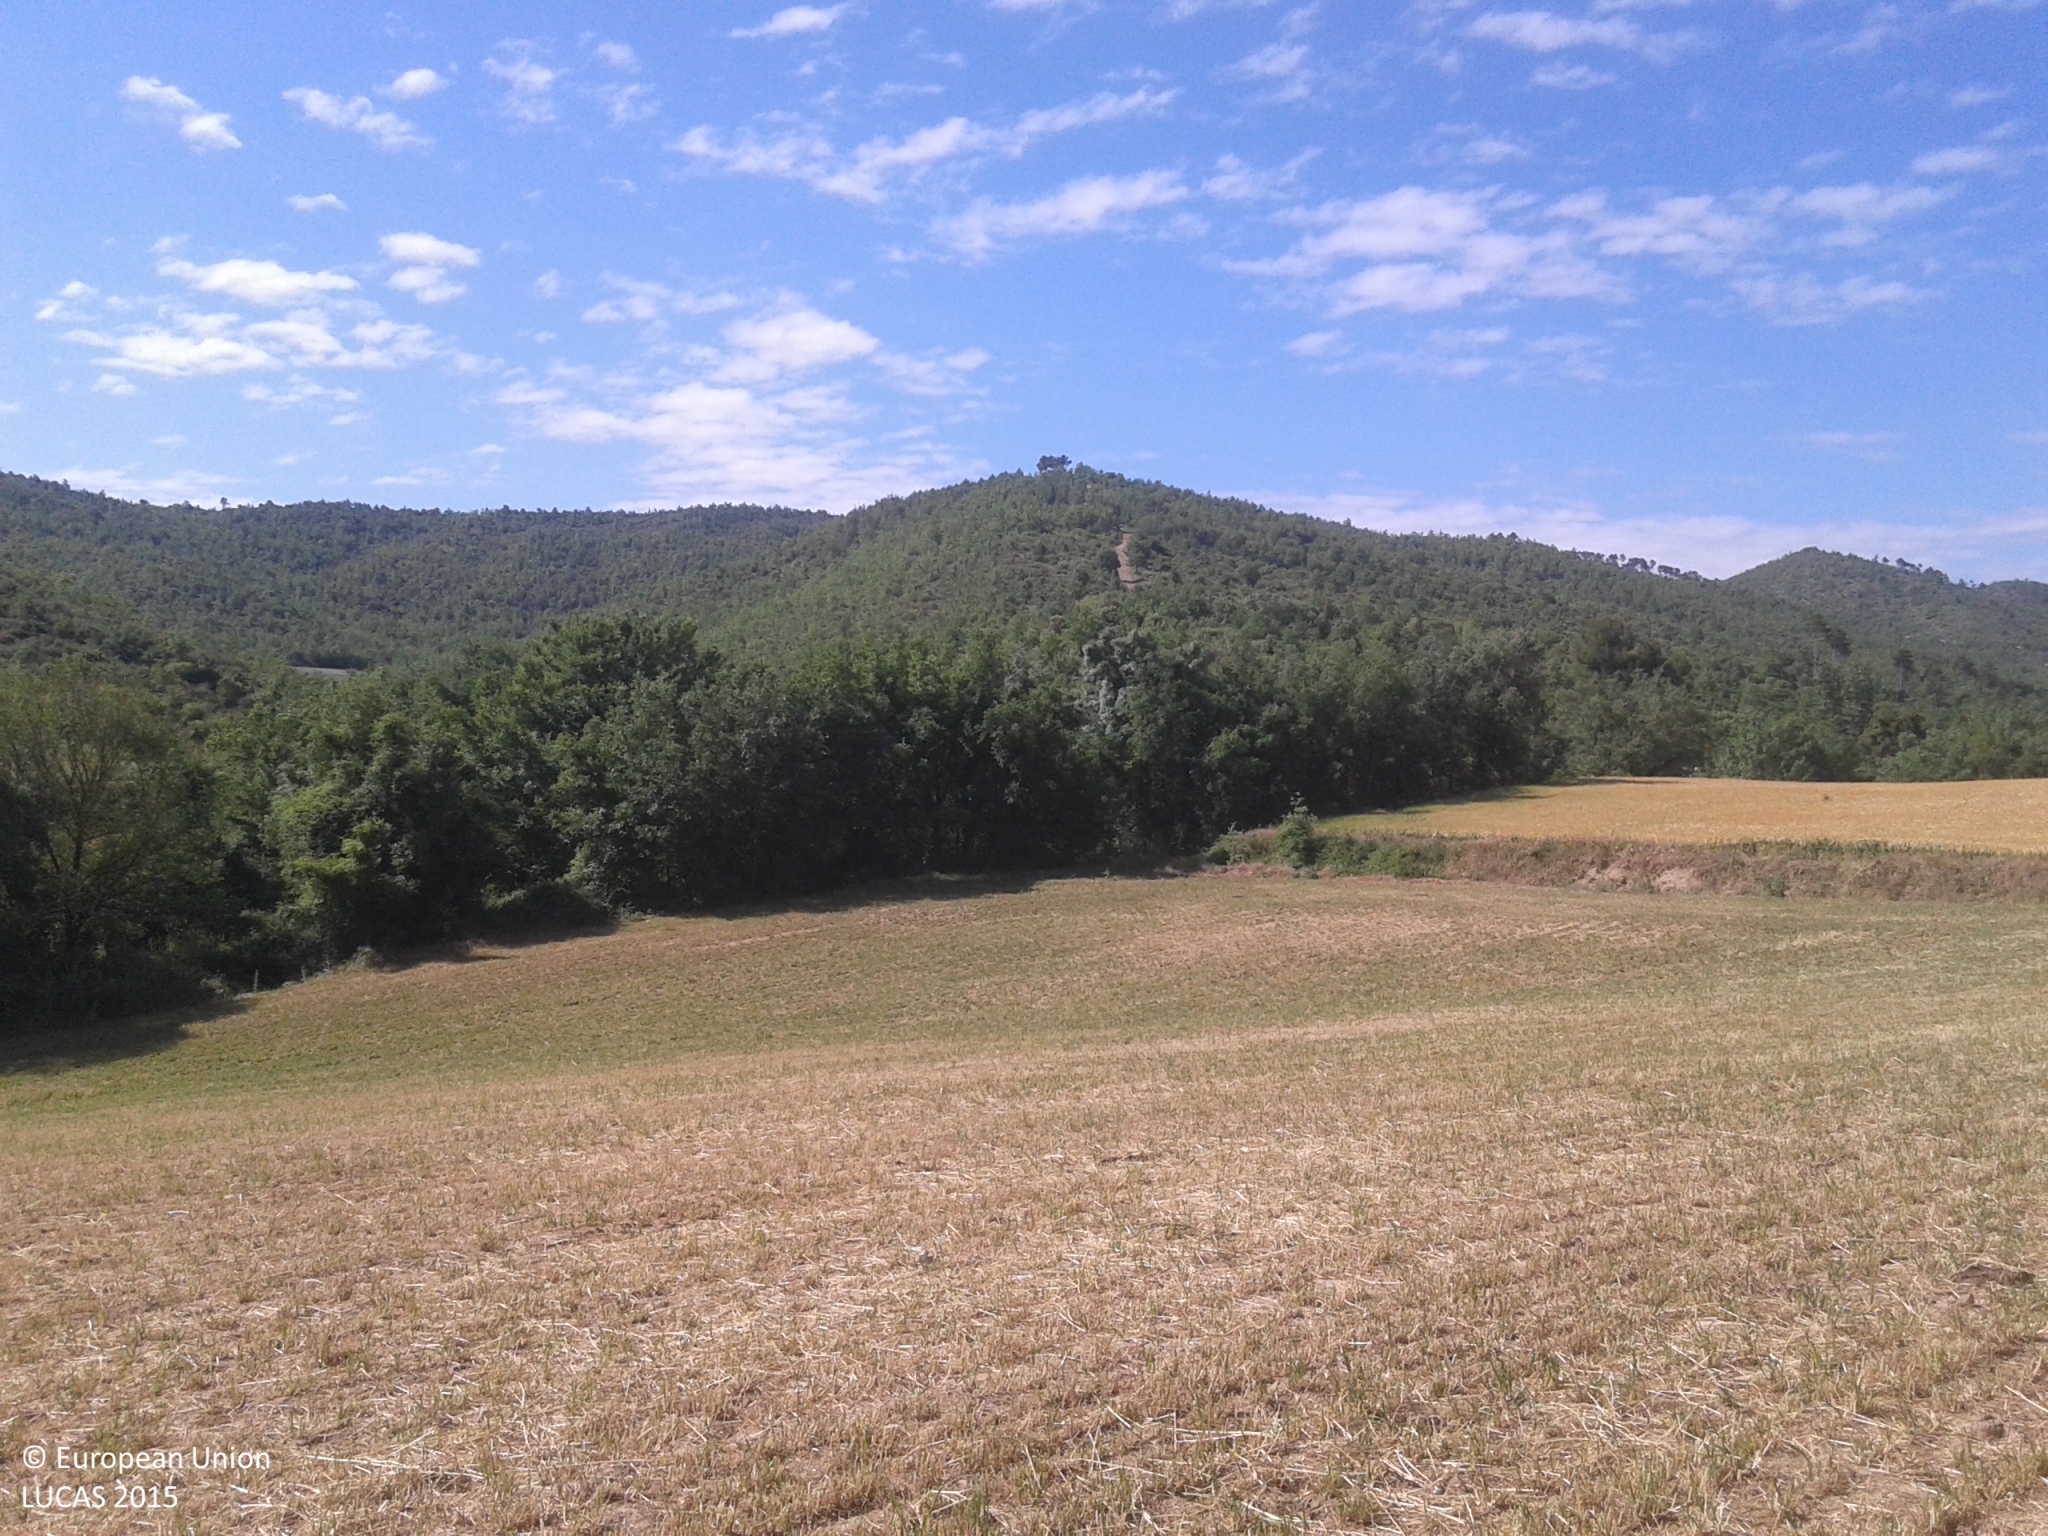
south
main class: Cropland
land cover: Rye
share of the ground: < 10 %
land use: Agriculture (excluding fallow land and kitchen gardens)
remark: Harvested field
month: May
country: ES
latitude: 41.9082
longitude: 1.6349
